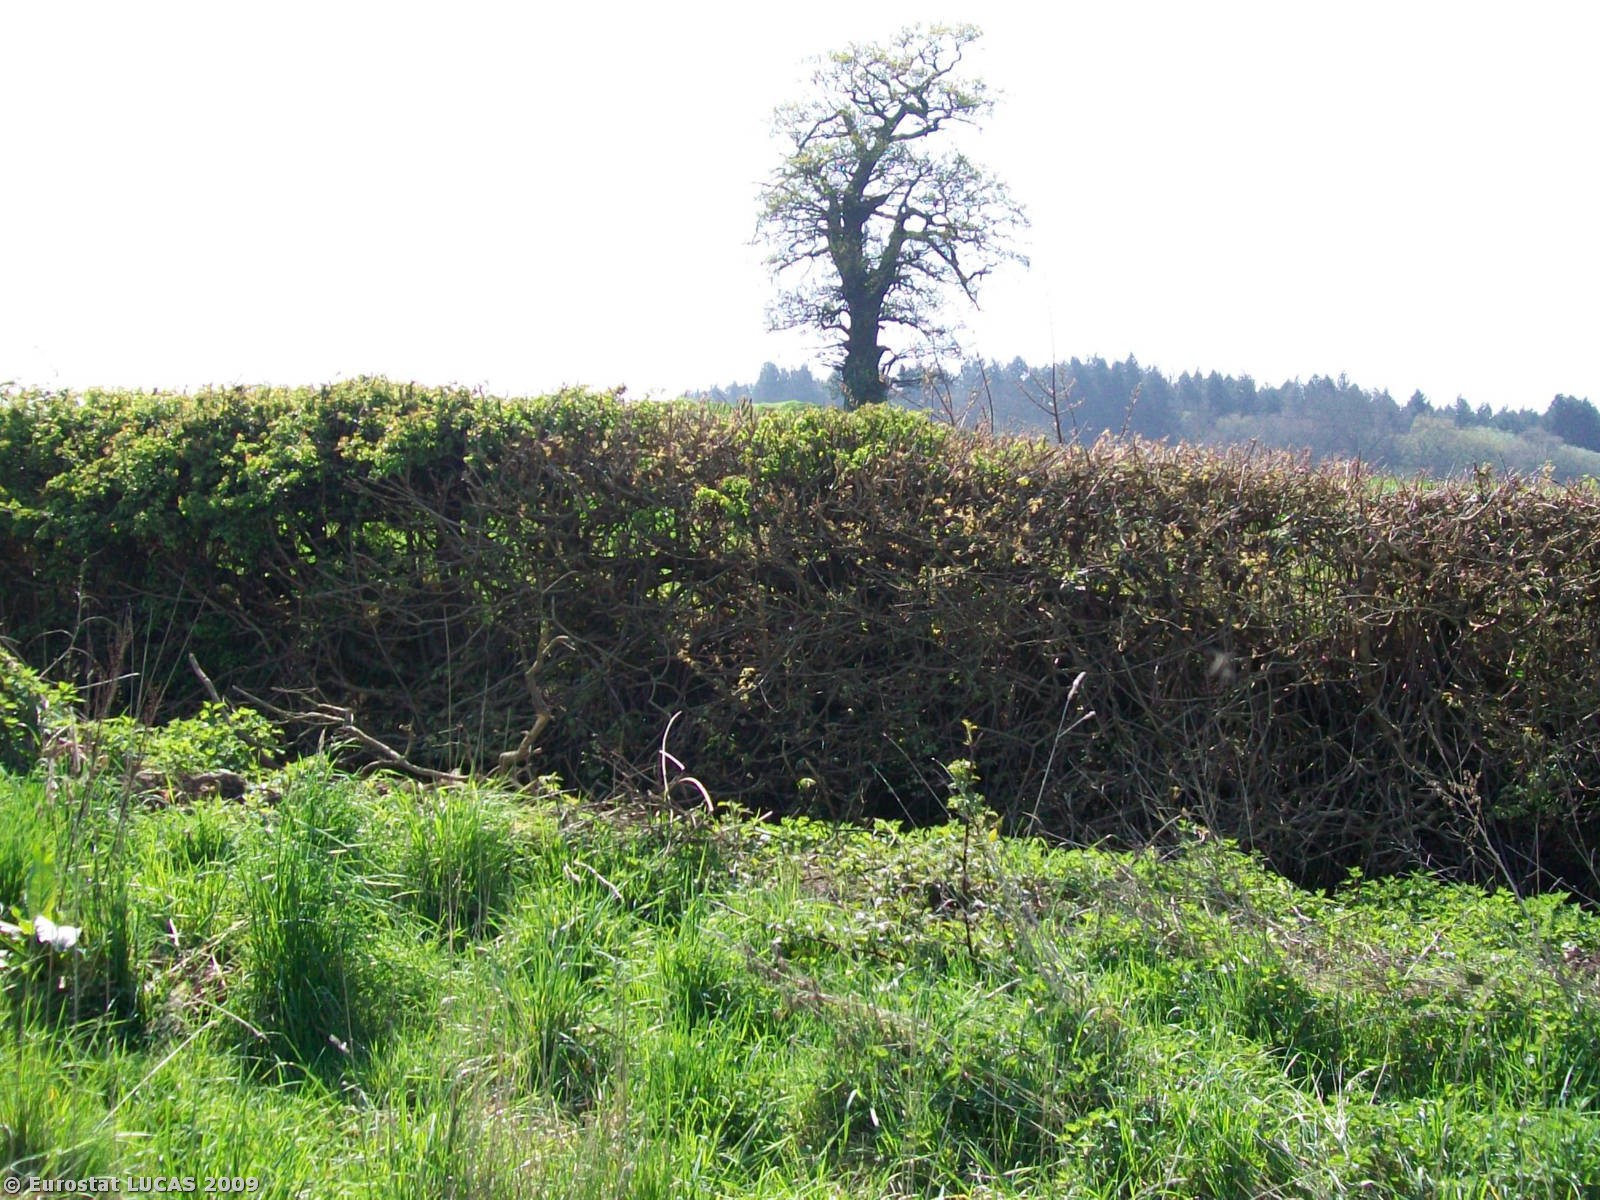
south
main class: Cropland
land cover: Rape and turnip rape
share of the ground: > 75 %
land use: Agriculture (excluding fallow land and kitchen gardens)
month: April
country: GB
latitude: 52.8371
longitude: -1.4658
